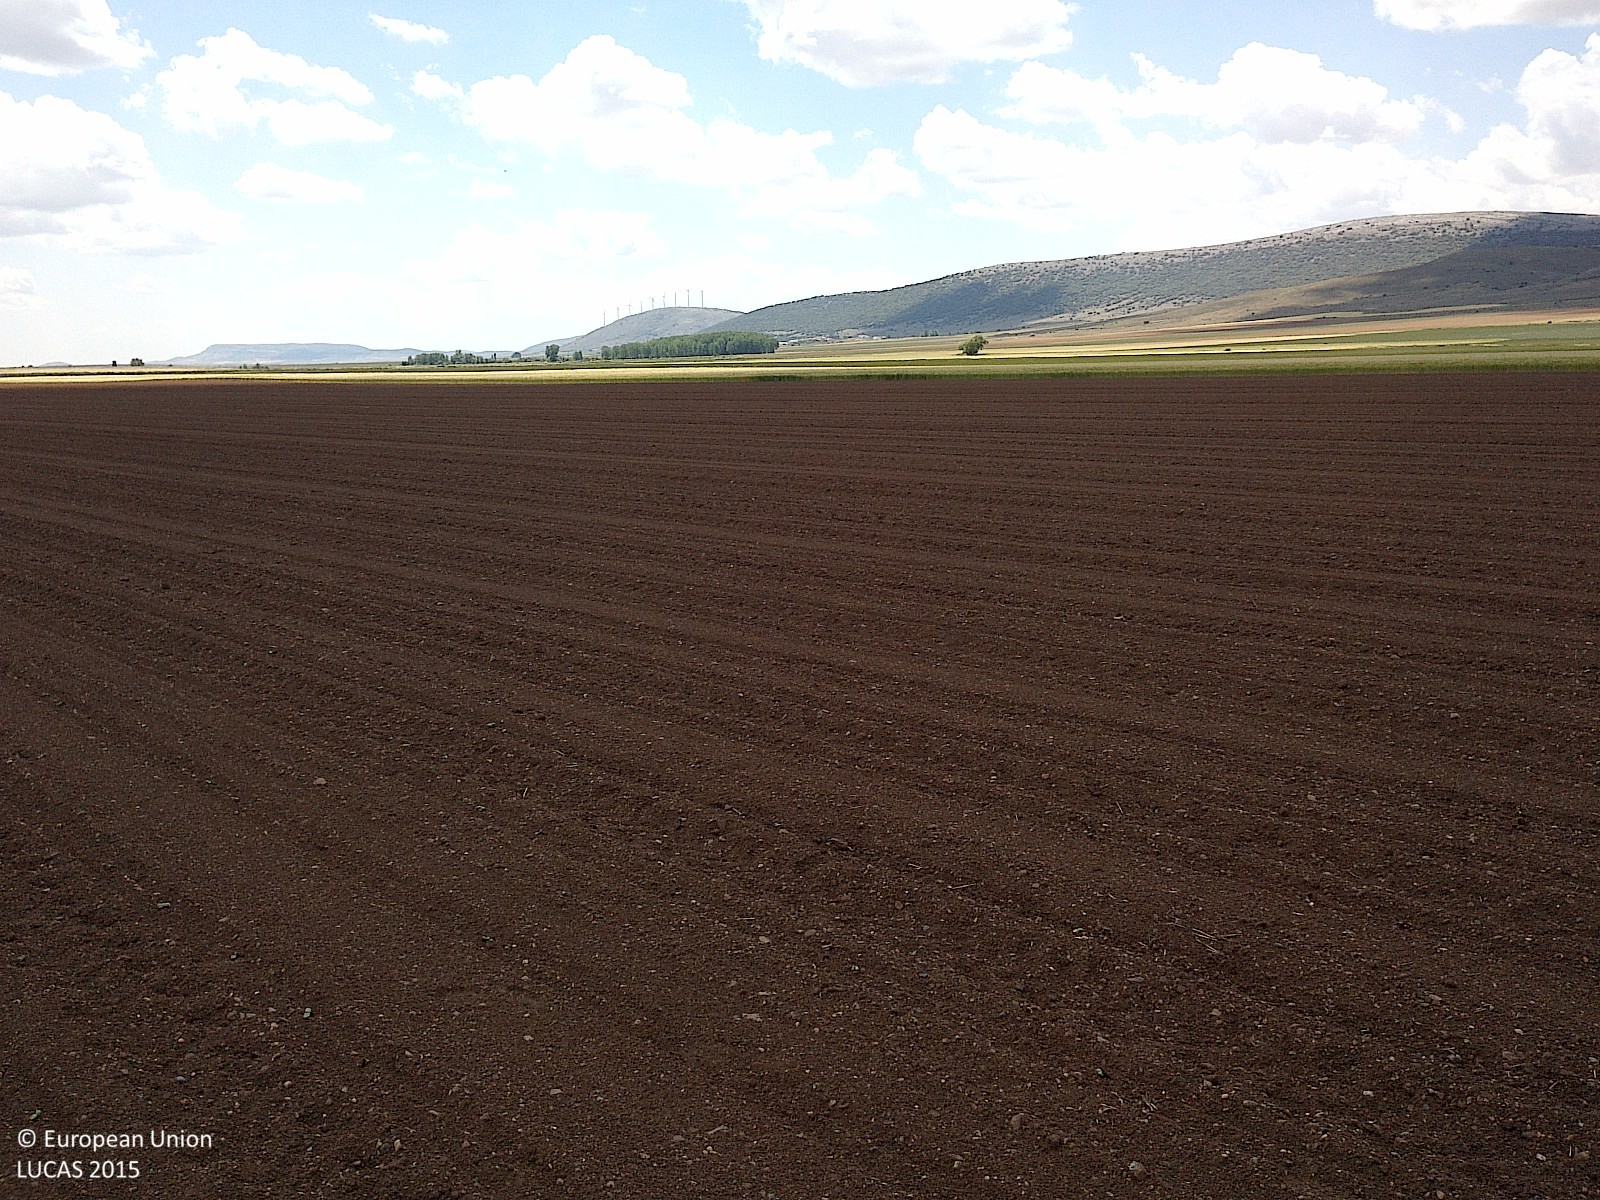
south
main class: Cropland
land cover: Sunflower
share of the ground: < 10 %
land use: Agriculture (excluding fallow land and kitchen gardens)
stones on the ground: < 10 %
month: June
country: ES
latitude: 41.7738
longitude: -2.1490
